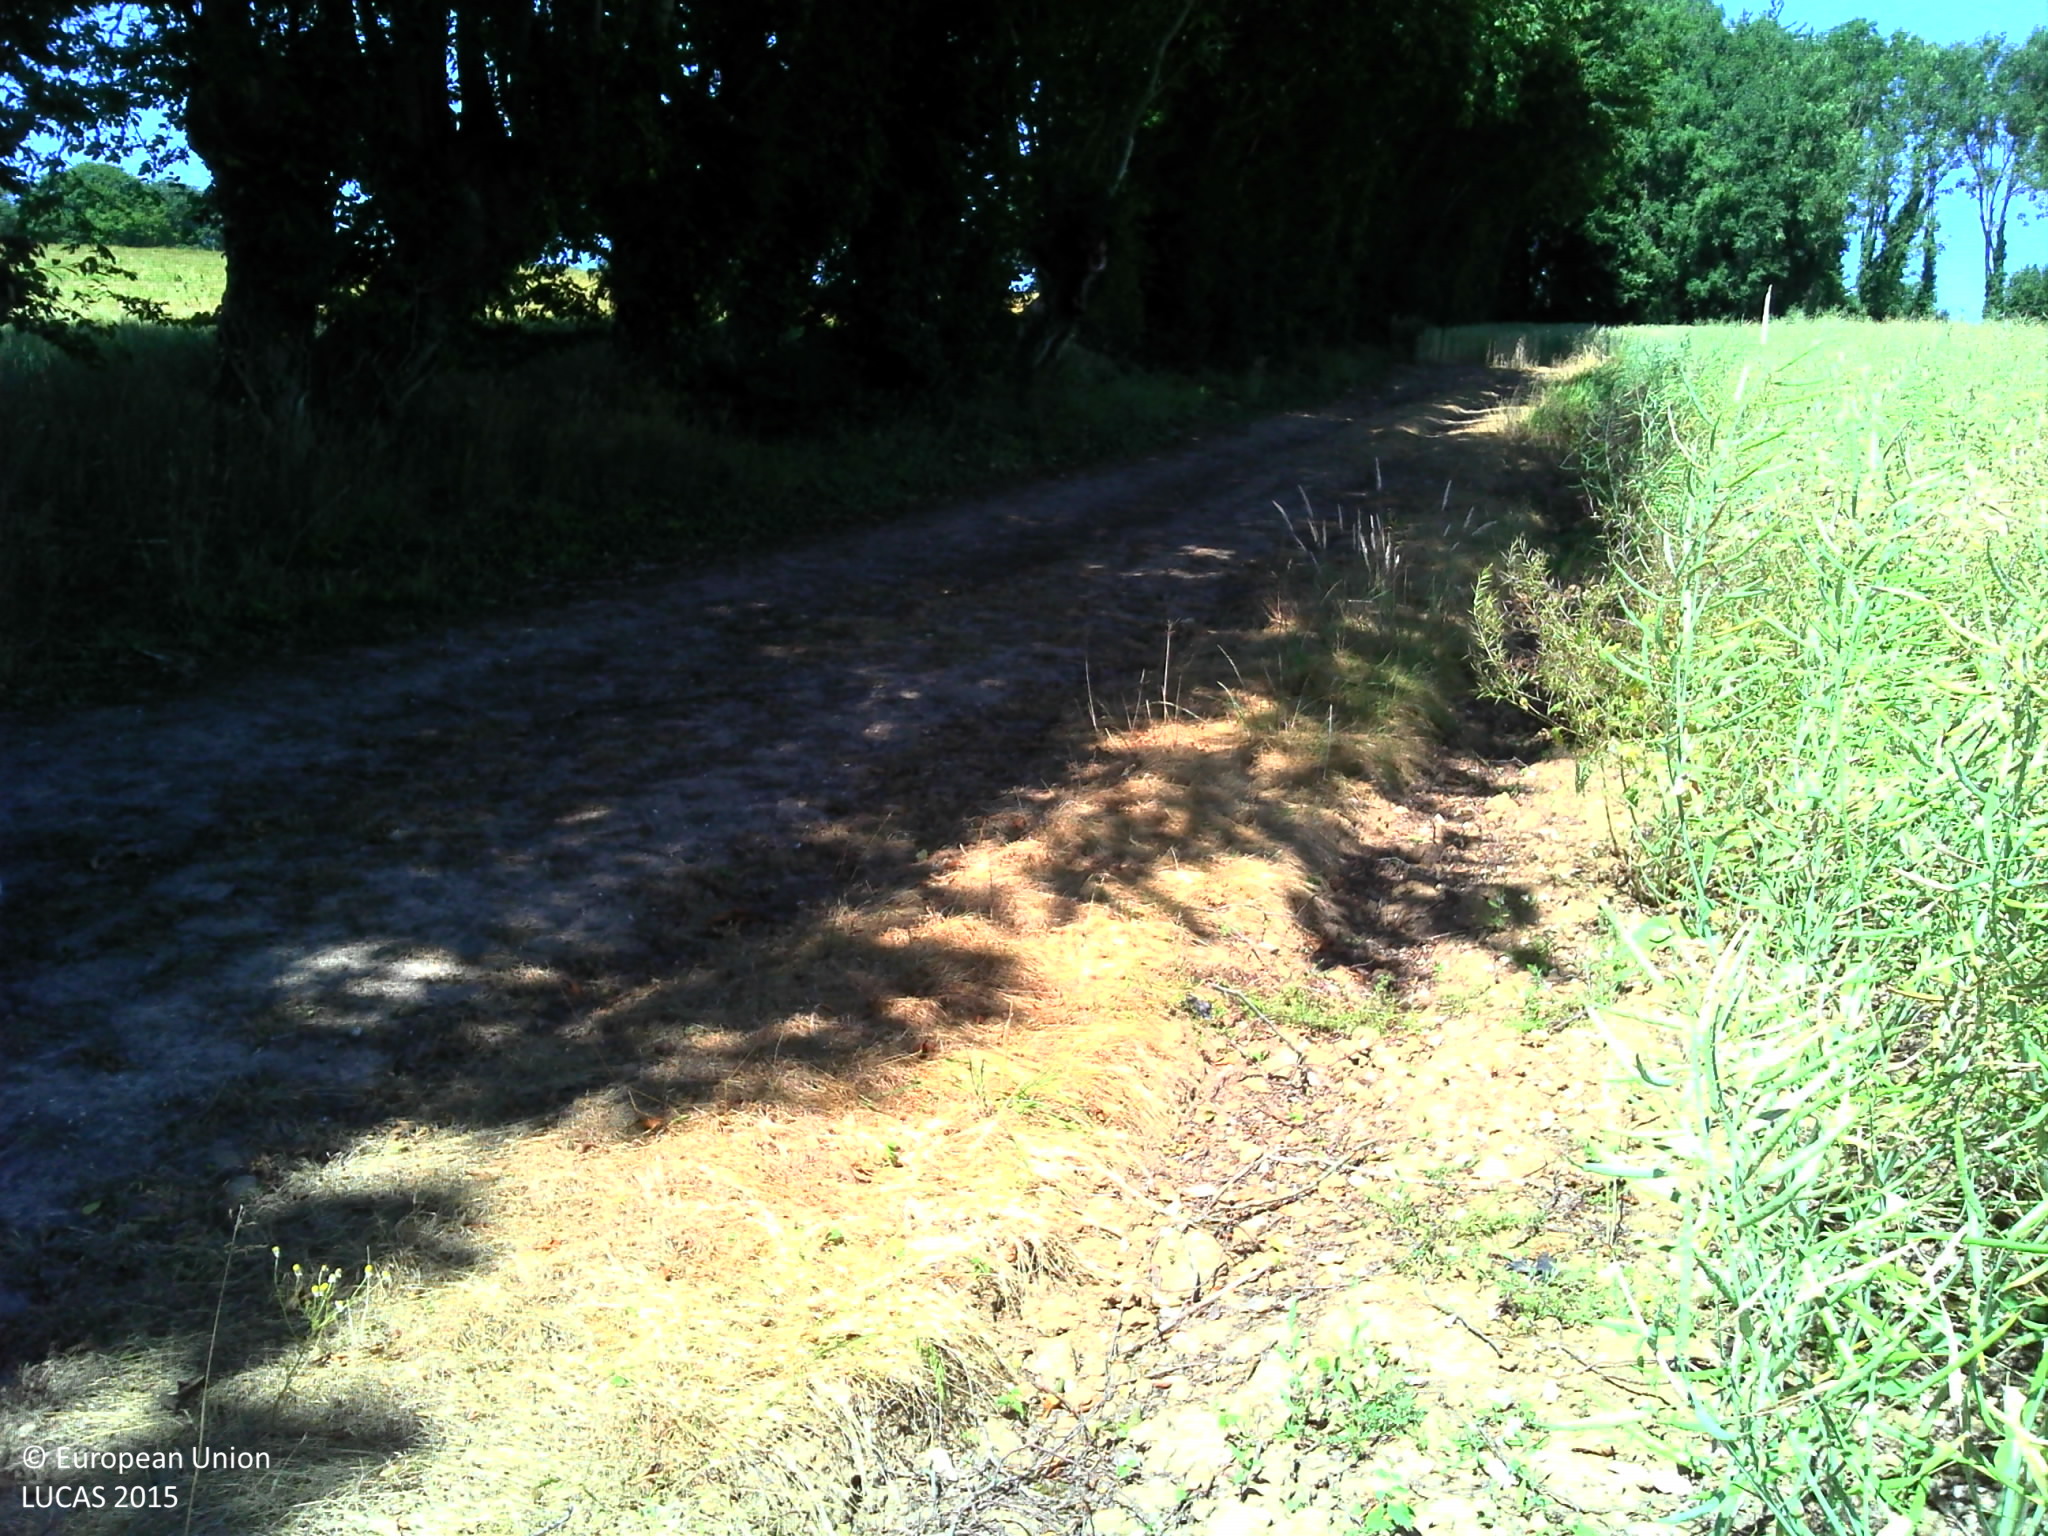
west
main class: Cropland
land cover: Rape and turnip rape
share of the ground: > 75 %
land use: Agriculture (excluding fallow land and kitchen gardens)
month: July
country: FR
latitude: 50.2563
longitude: 2.1448
